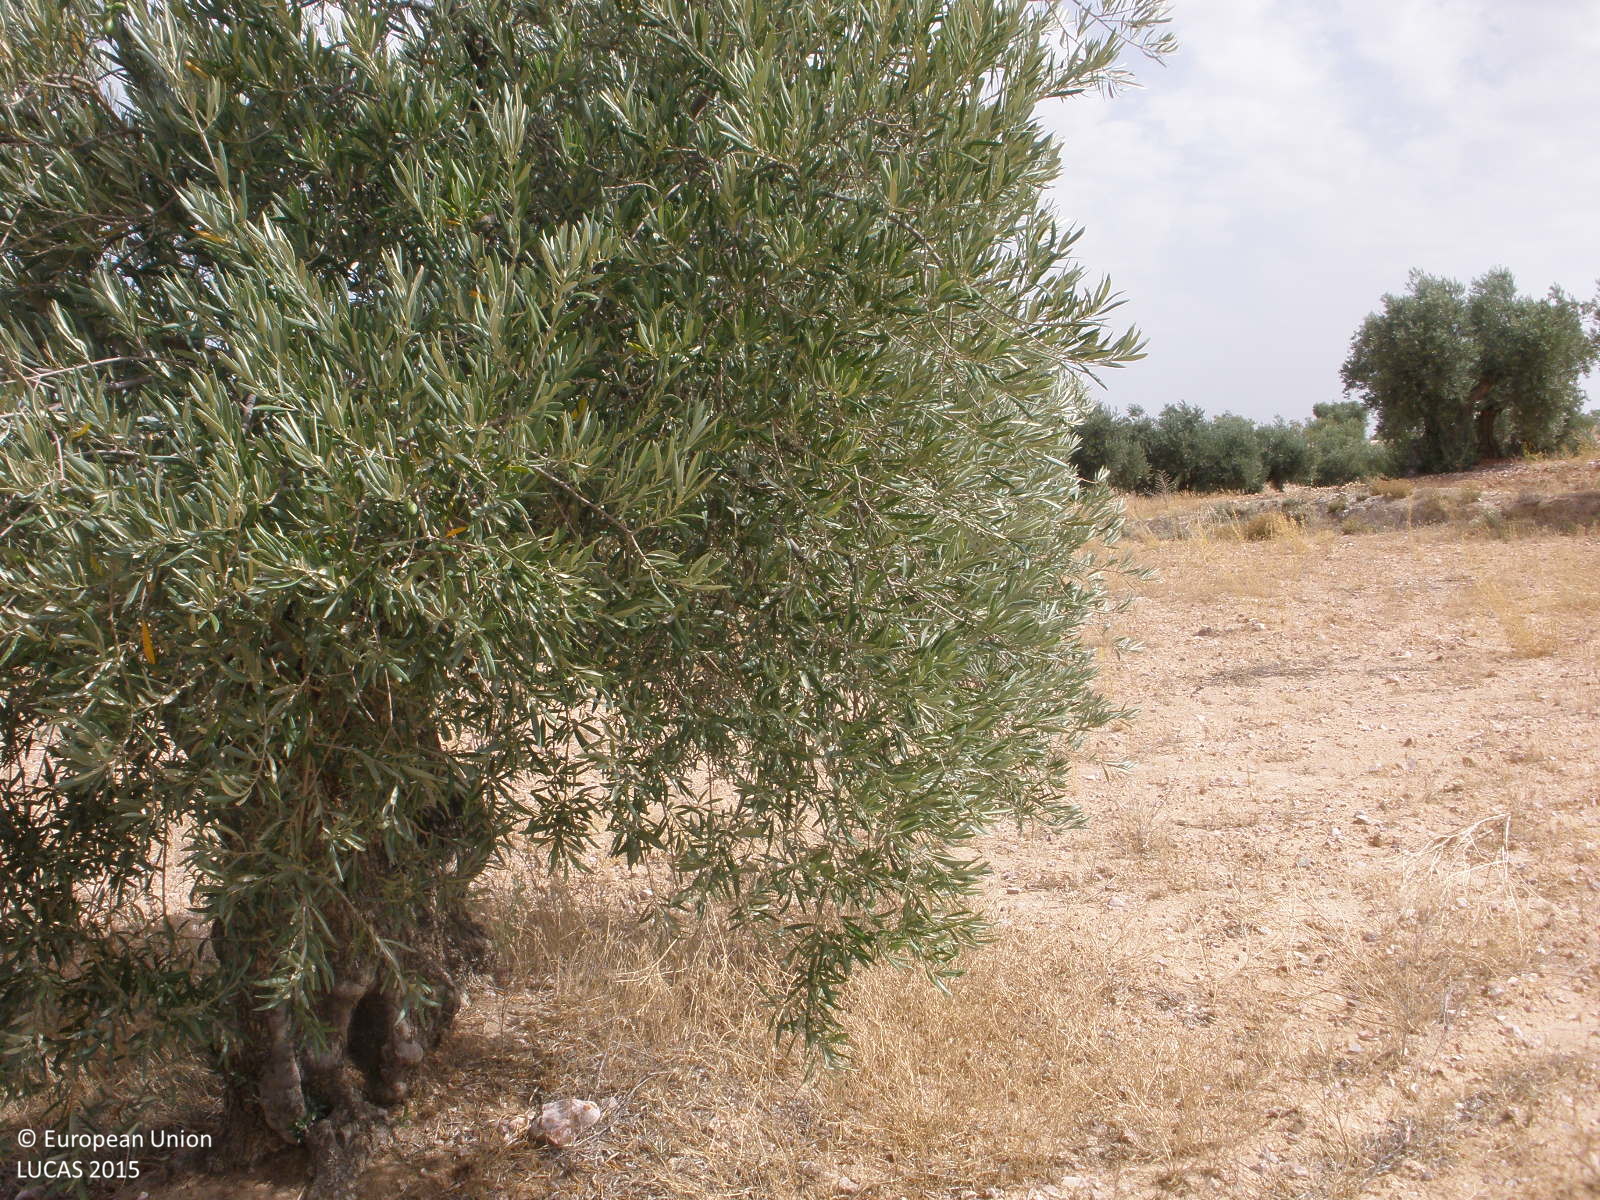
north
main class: Cropland
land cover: Olive groves
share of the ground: 25 - 50 %
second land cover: Spontaneously vegetated surfaces
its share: 50 - 75 %
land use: Agriculture (excluding fallow land and kitchen gardens)
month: July
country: ES
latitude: 39.6706
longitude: -3.4185
